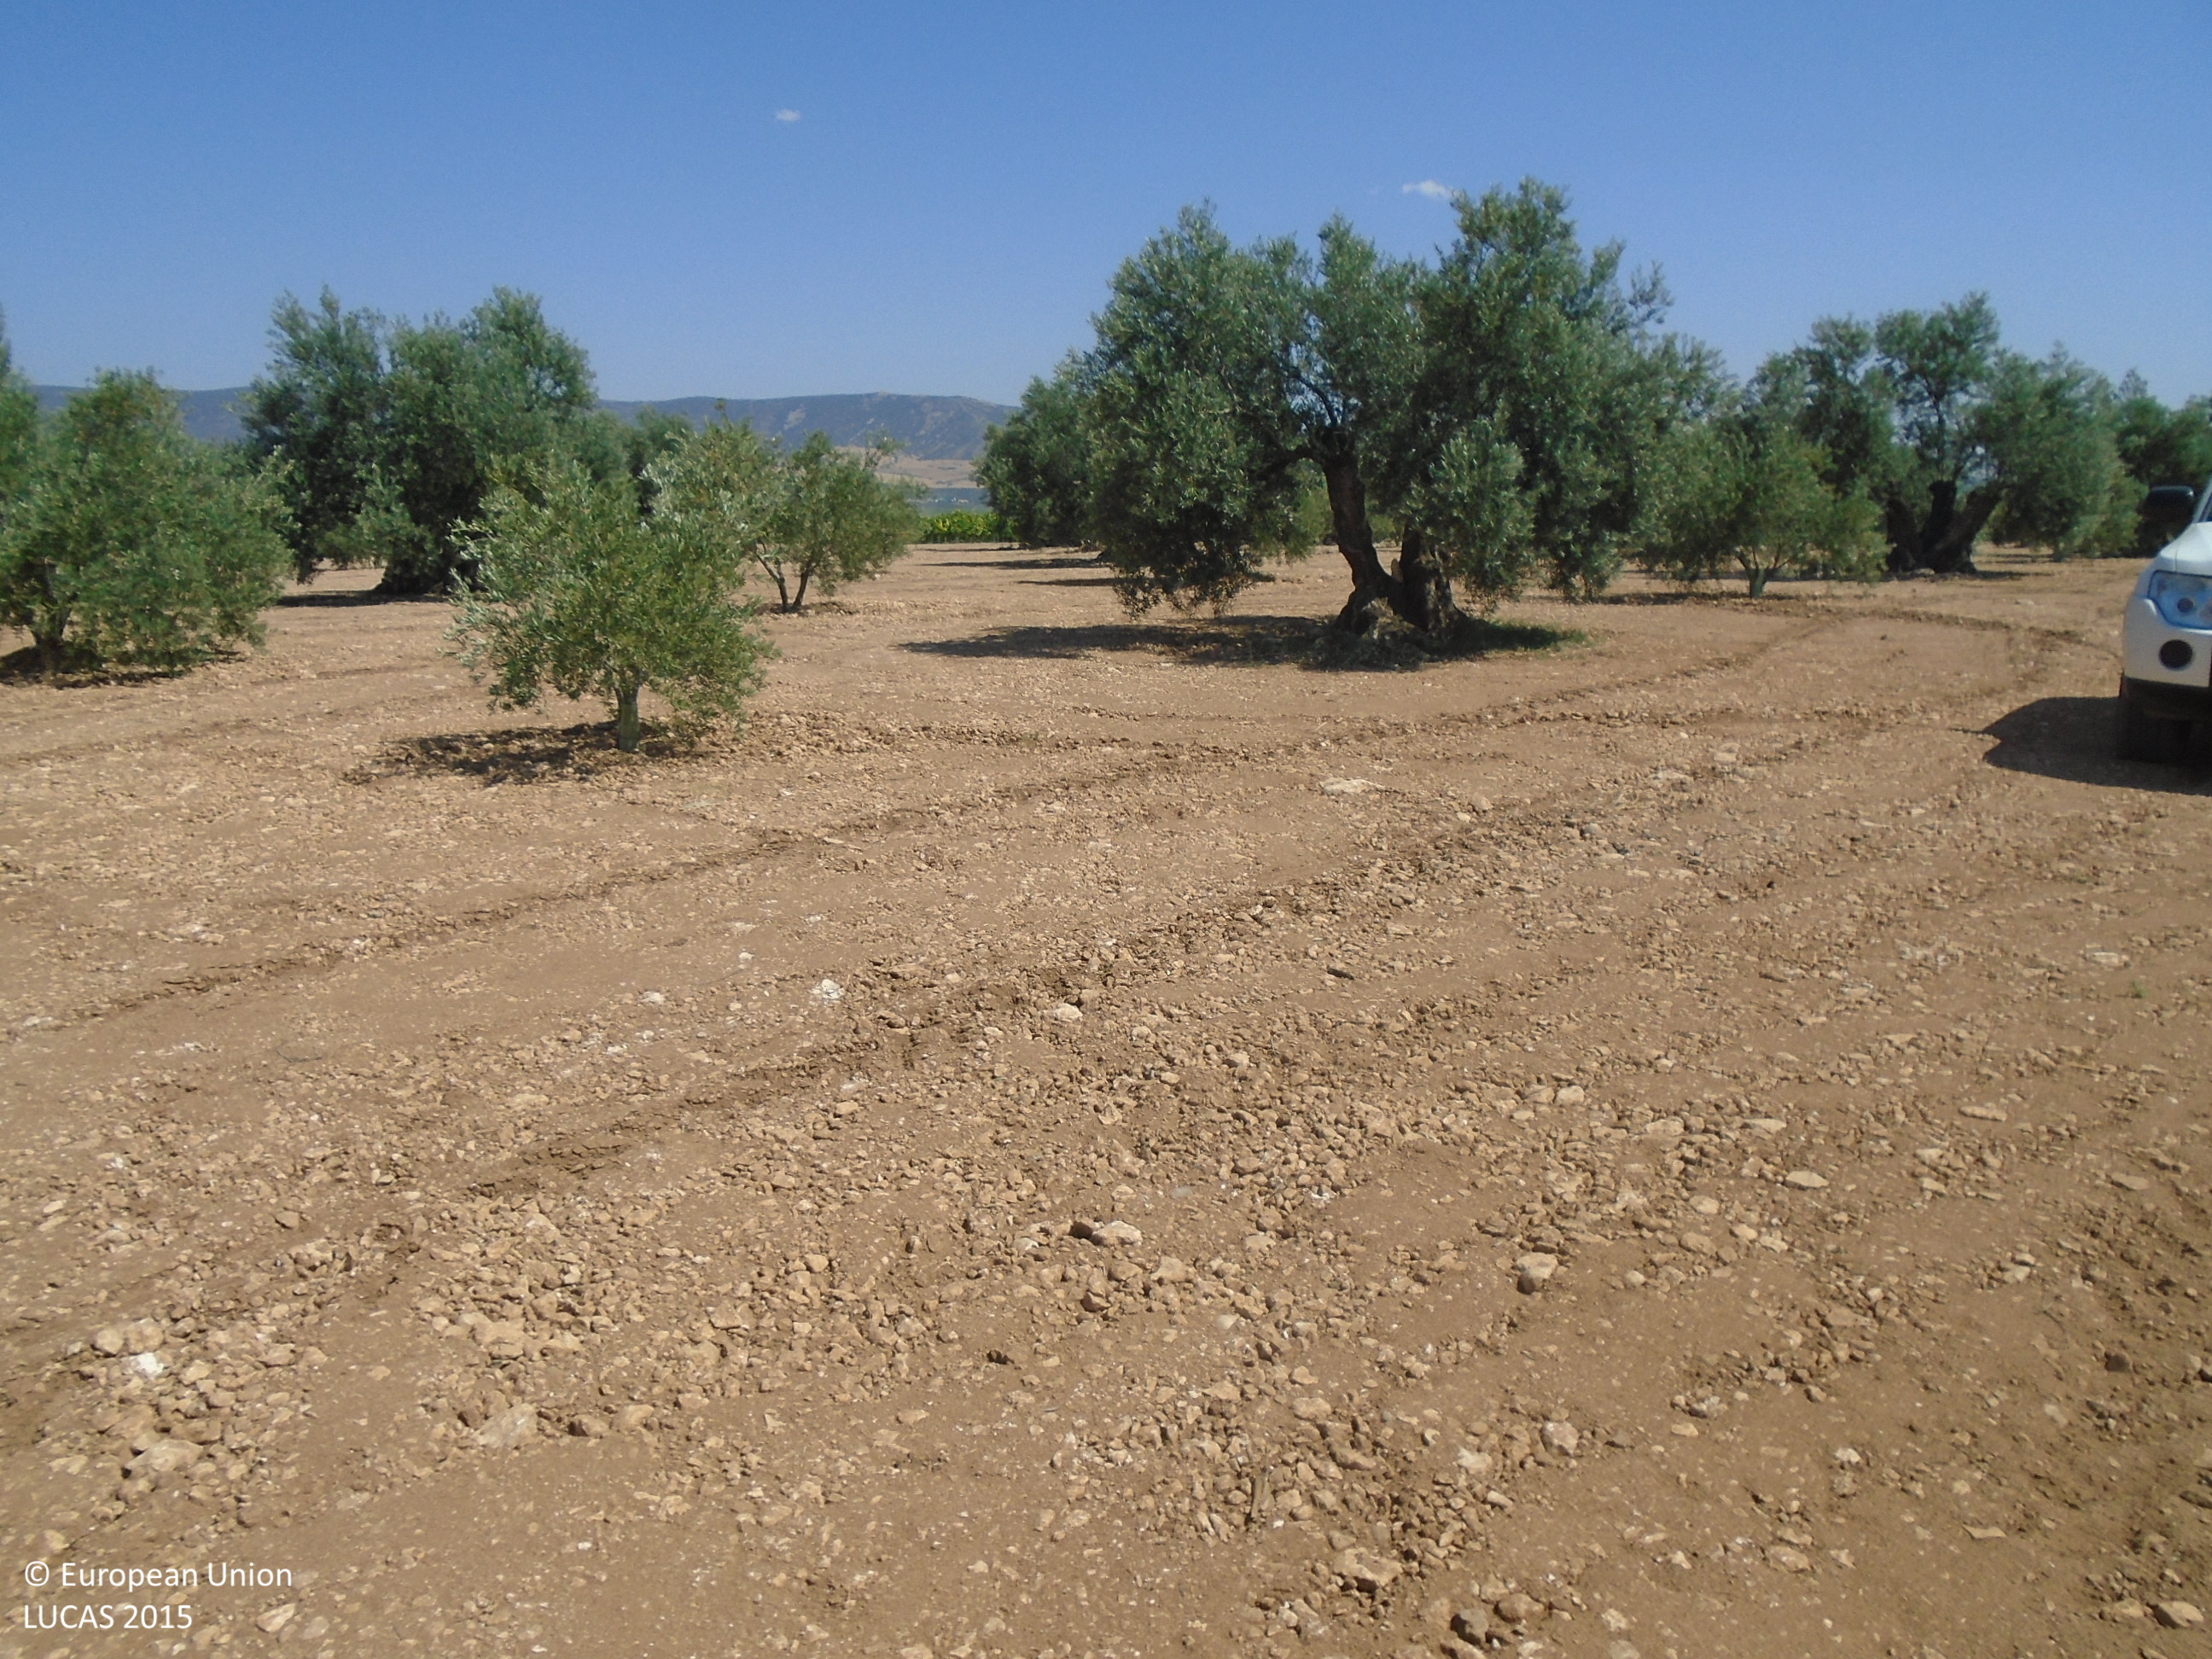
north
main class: Cropland
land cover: Olive groves
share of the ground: 10 - 25 %
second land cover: Other bare soil
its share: > 75 %
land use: Agriculture (excluding fallow land and kitchen gardens)
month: June
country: ES
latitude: 39.1630
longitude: -3.6414
